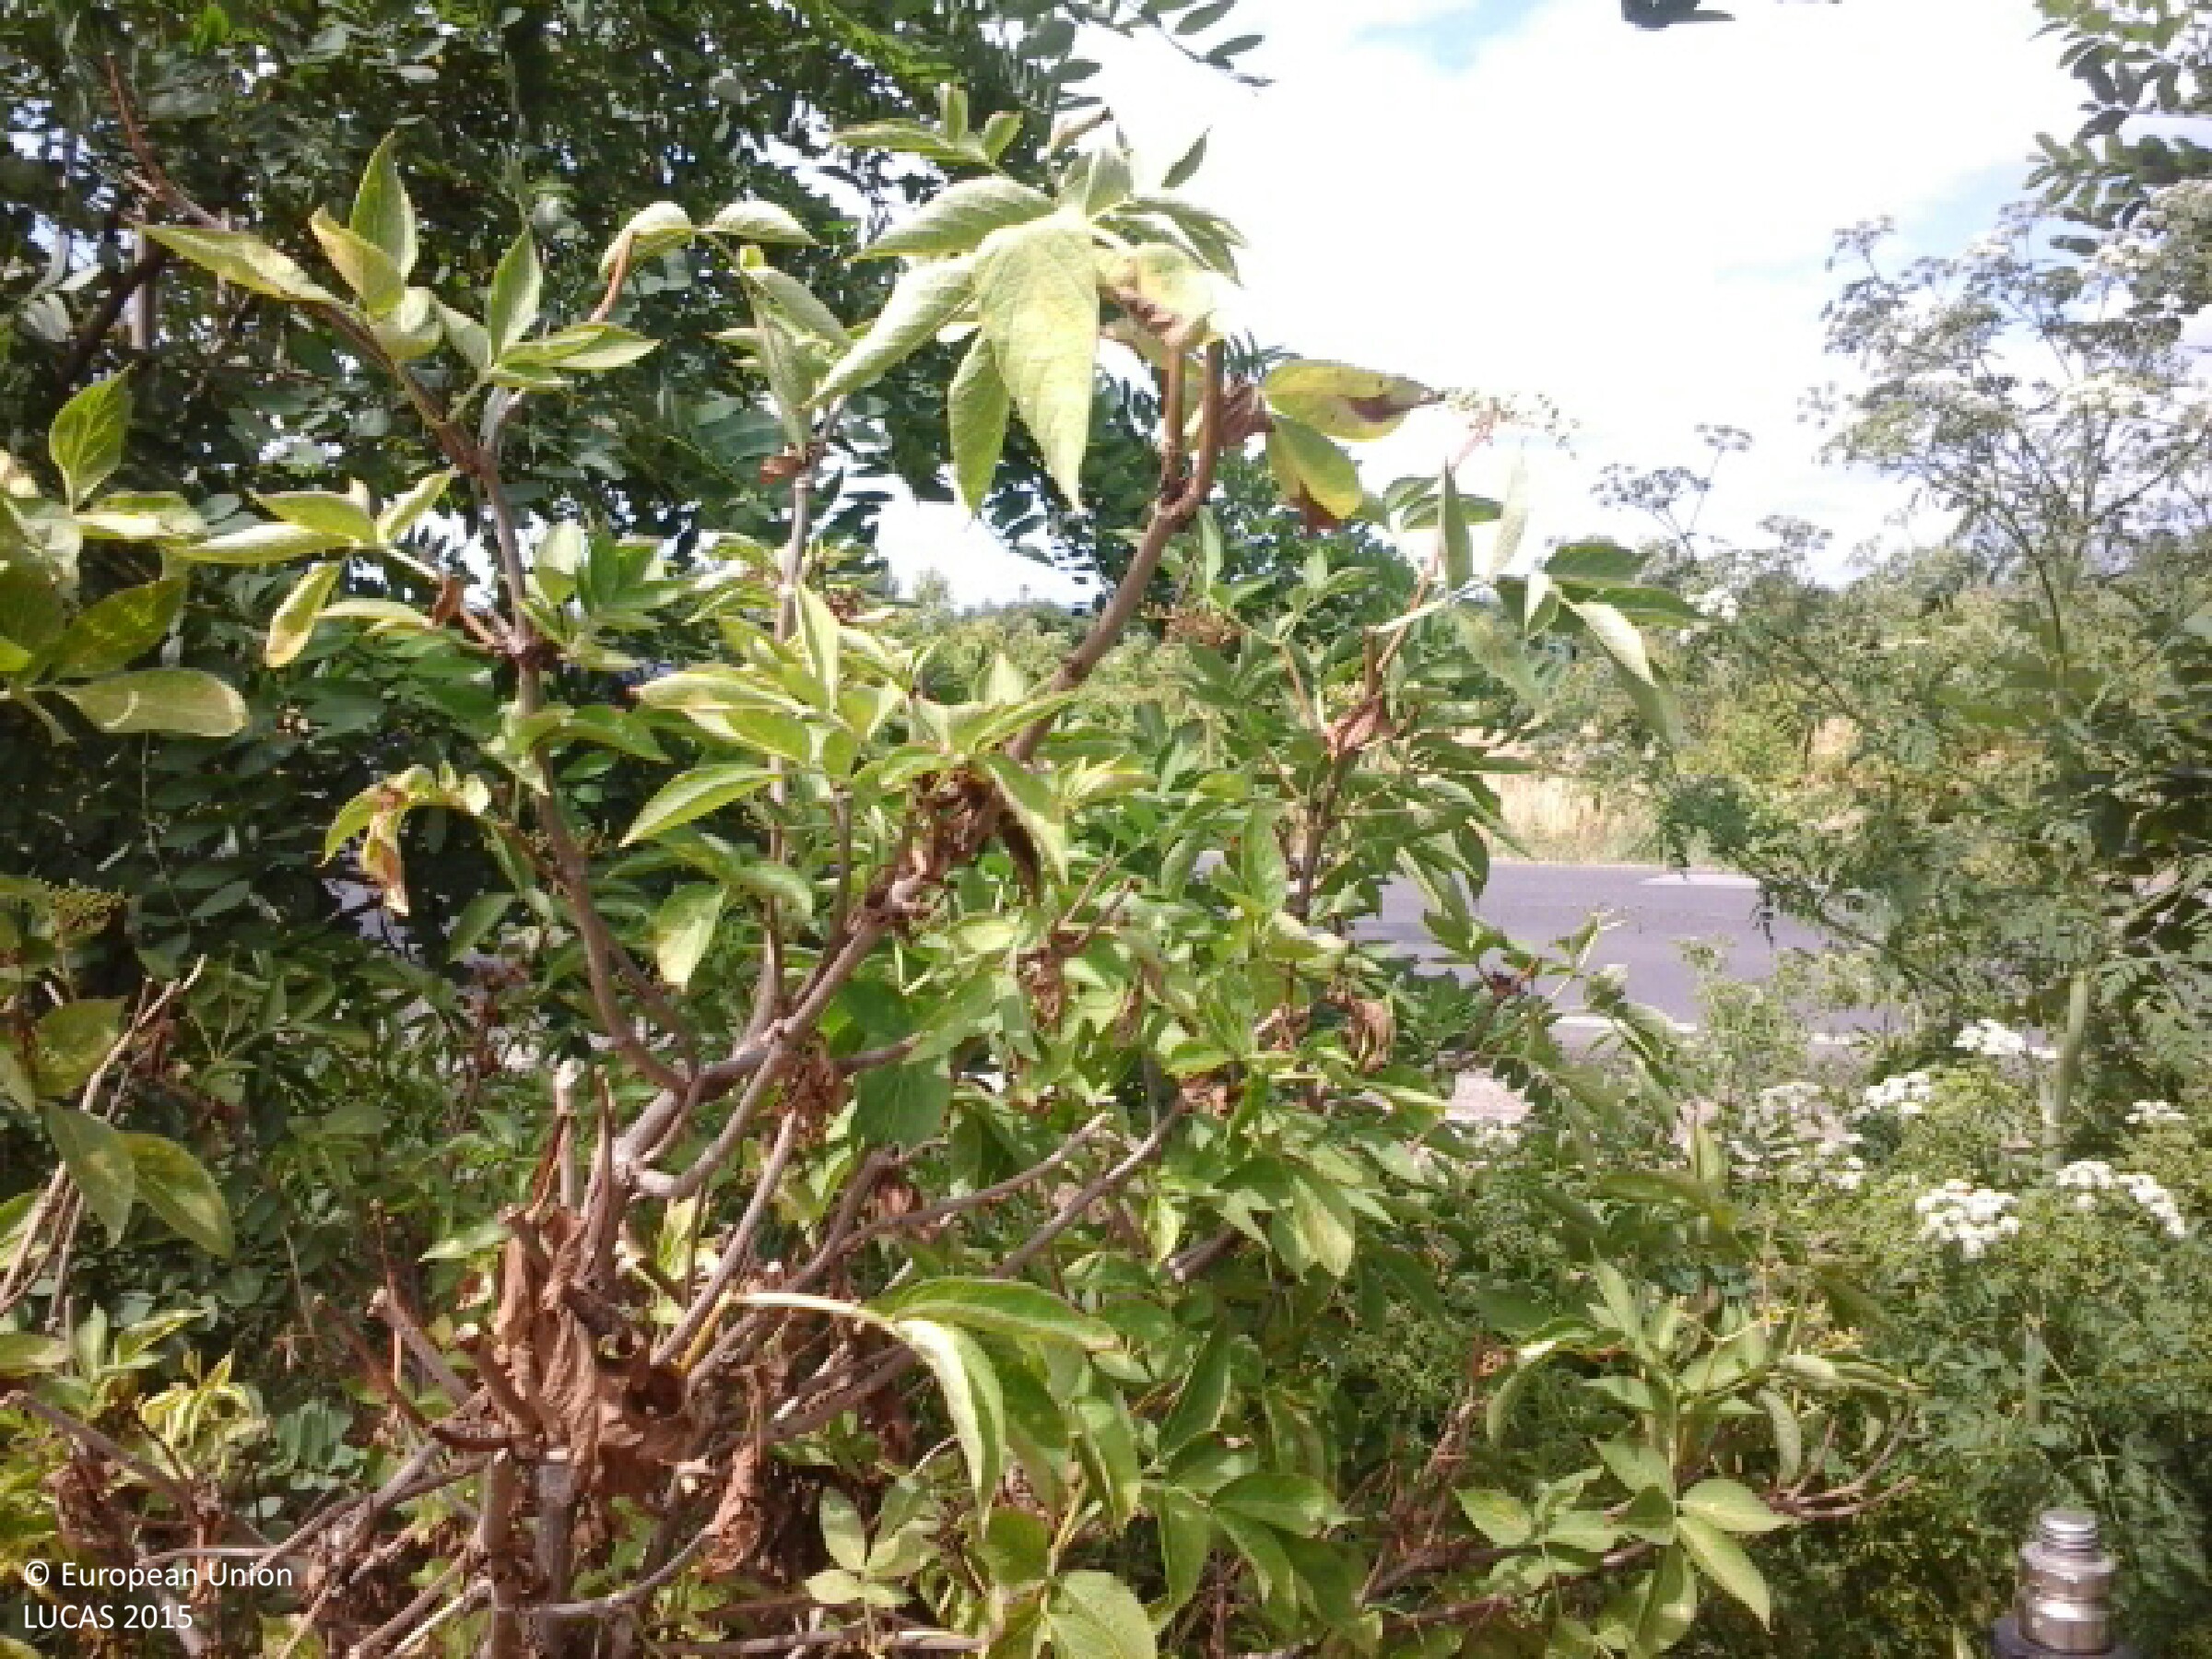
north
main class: Shrubland
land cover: Shrubland with sparse tree cover
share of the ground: 50 - 75 %
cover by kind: shrubs 70 %, herbaceous plants 25 %, broadleaved forest trees 5 %
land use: Road transport
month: June
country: HU
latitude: 48.0717
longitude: 21.5208
